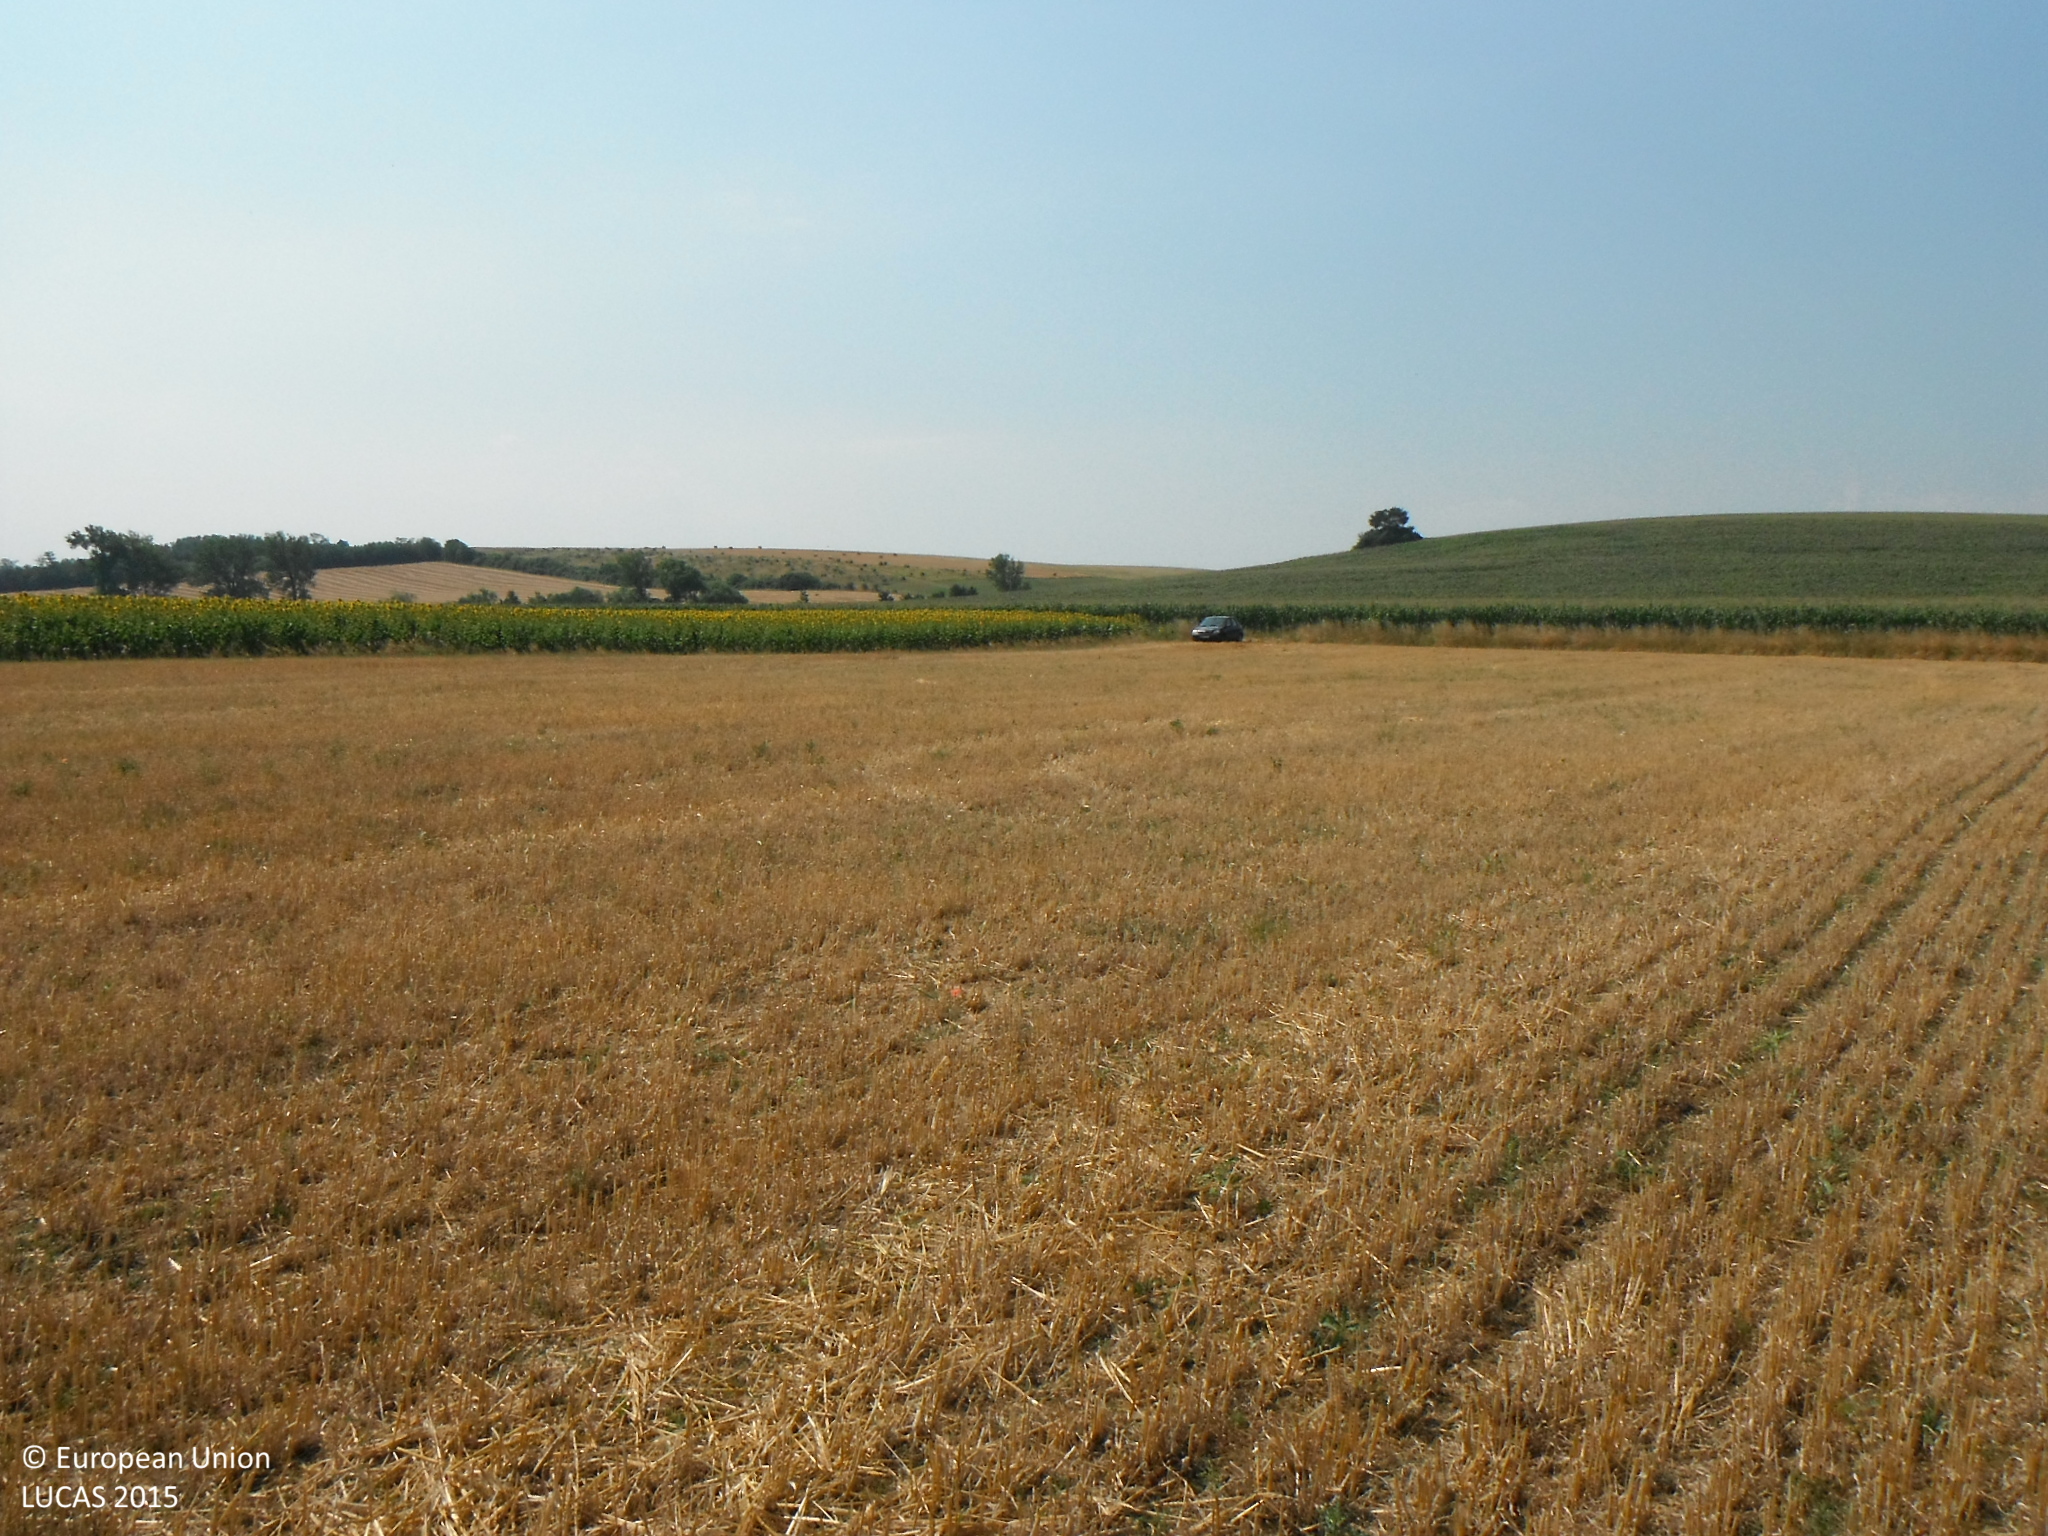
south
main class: Cropland
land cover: Barley
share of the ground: > 75 %
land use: Agriculture (excluding fallow land and kitchen gardens)
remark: Harvested field
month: July
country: SK
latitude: 48.3251
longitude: 20.0507
